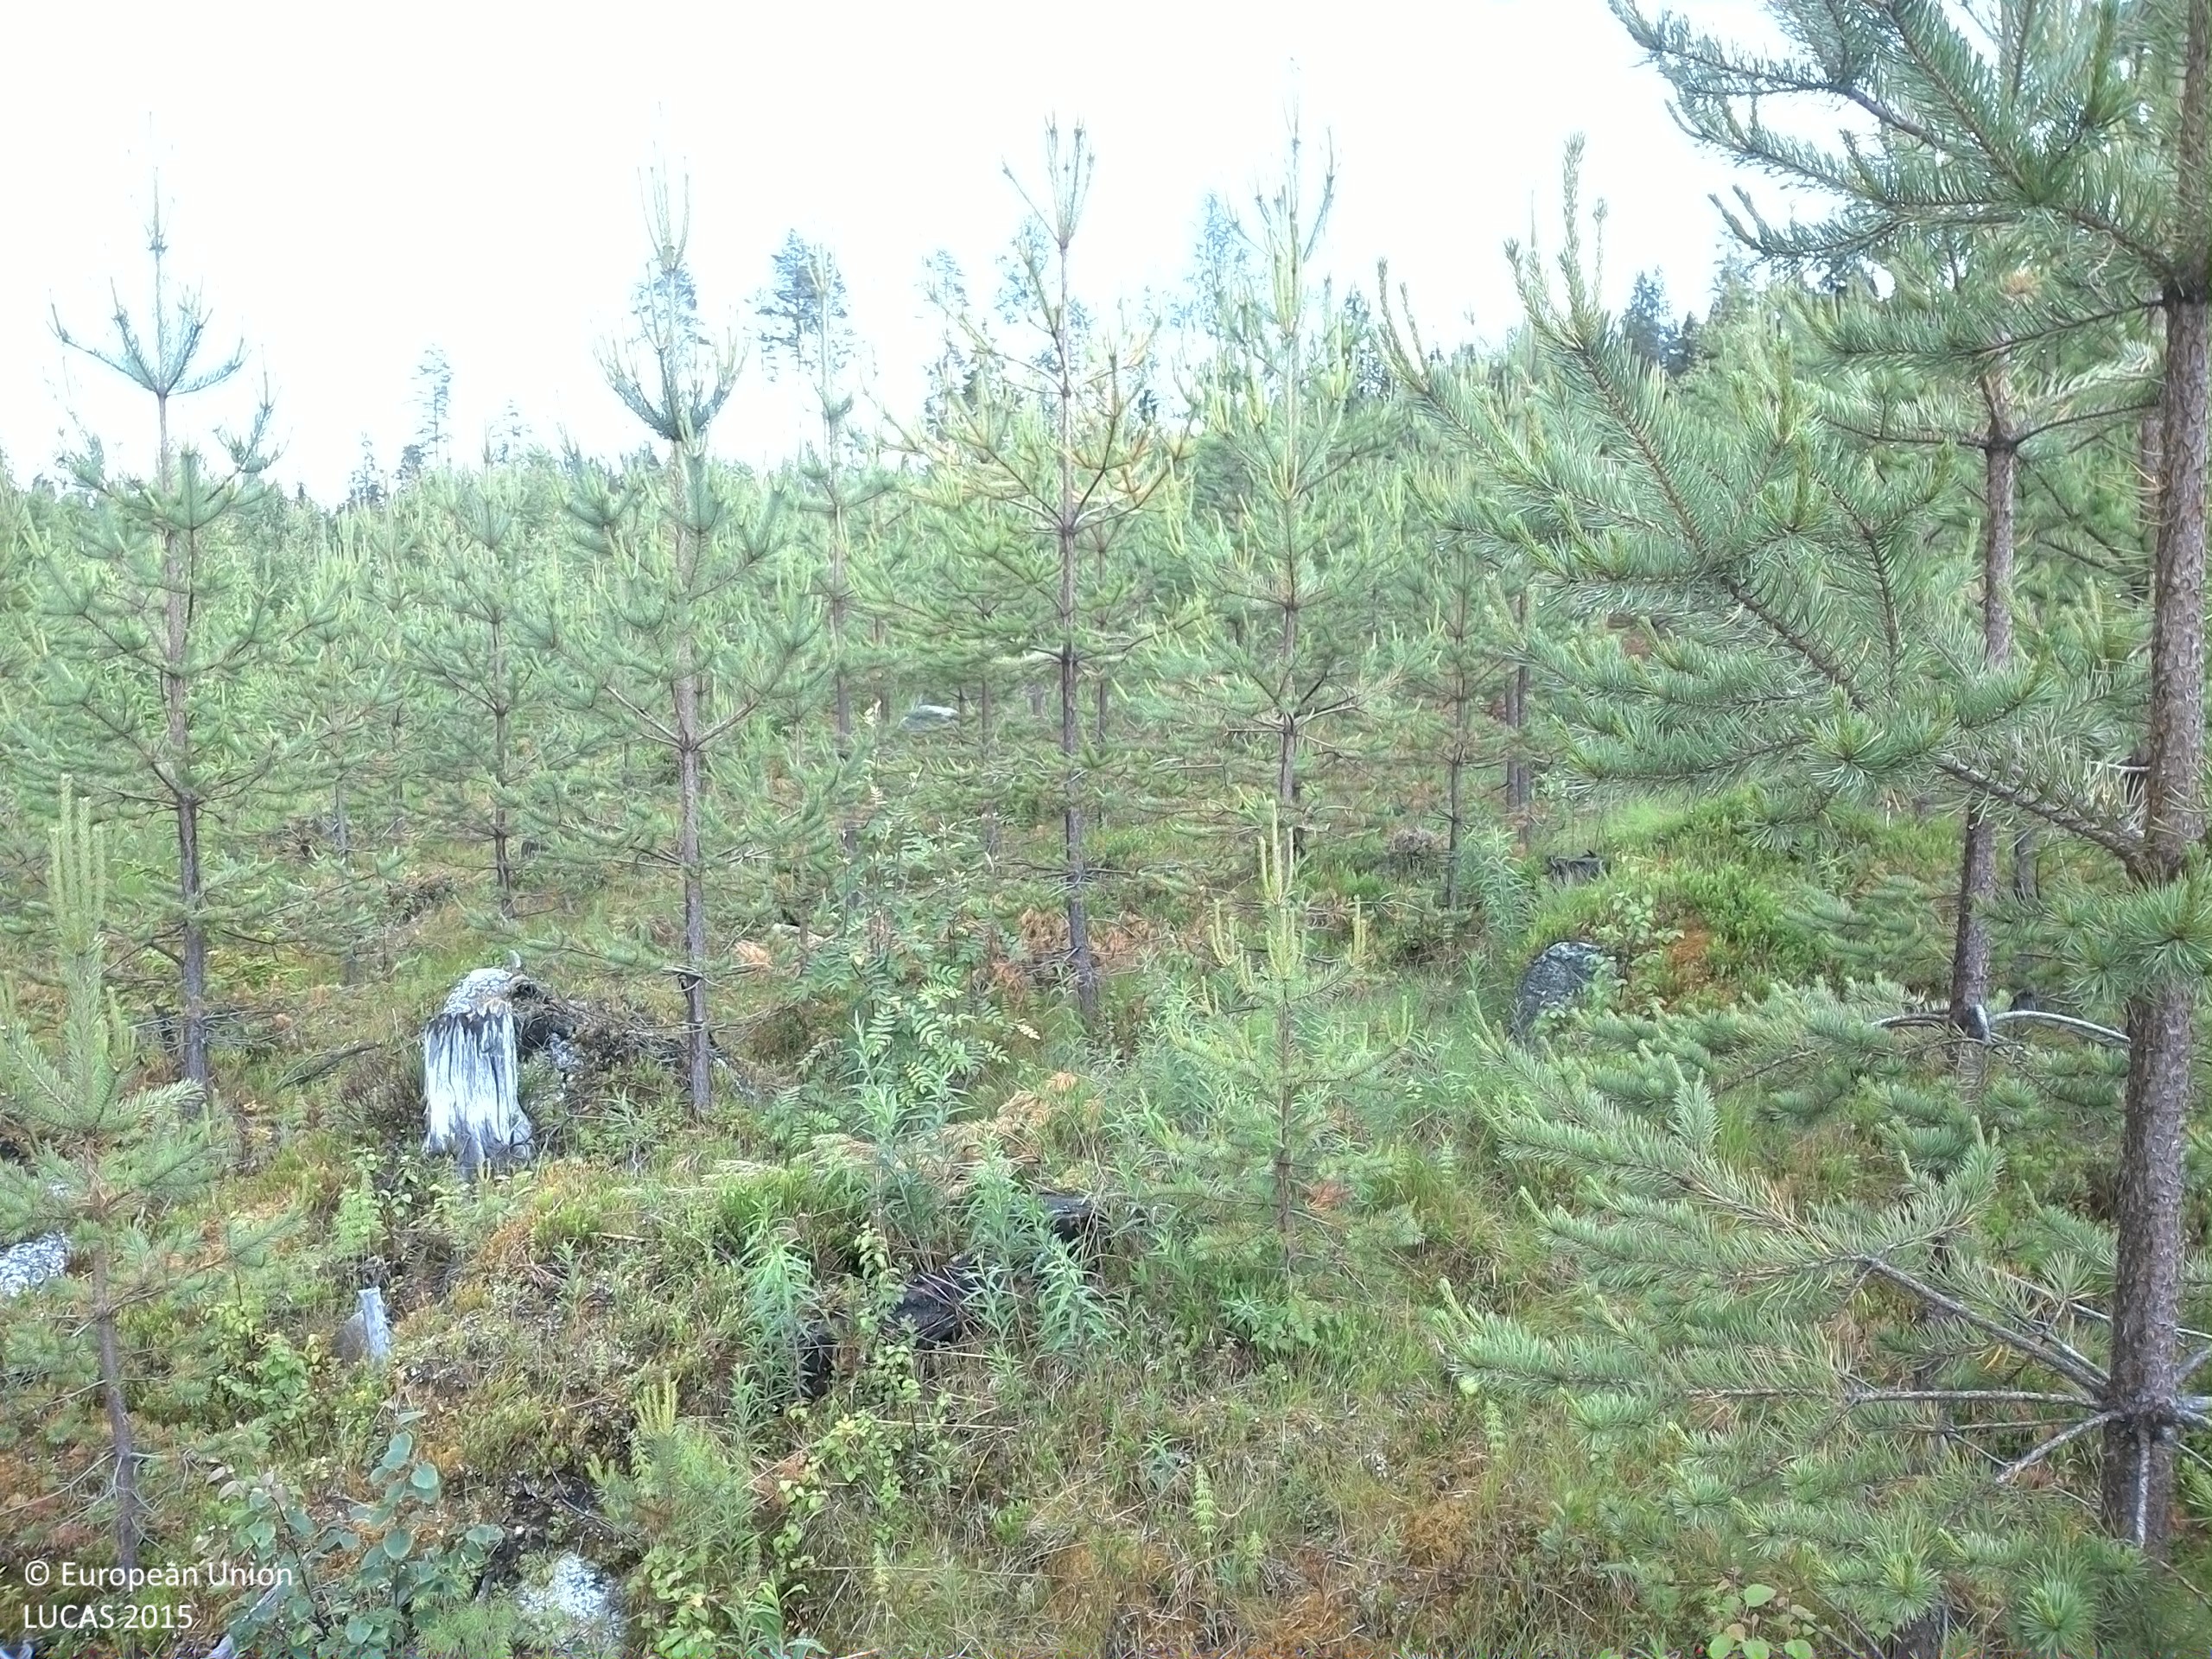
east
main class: Woodland
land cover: Pine dominated coniferous woodland
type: boreal forest
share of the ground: 25 - 50 %
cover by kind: coniferous forest trees 40 %, shrubs 20 %, herbaceous plants 20 %, lichens and mosses 15 %, broadleaved forest trees 5 %
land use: Forestry
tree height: < 5 m
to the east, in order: Pine dominated coniferous woodland; Pine dominated mixed woodland; Spruce dominated mixed woodland; Pine dominated mixed woodland; Spruce dominated mixed woodland; Rivers and streams; Broadleaved woodland
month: July
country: SE
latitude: 63.6156
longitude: 18.6686
